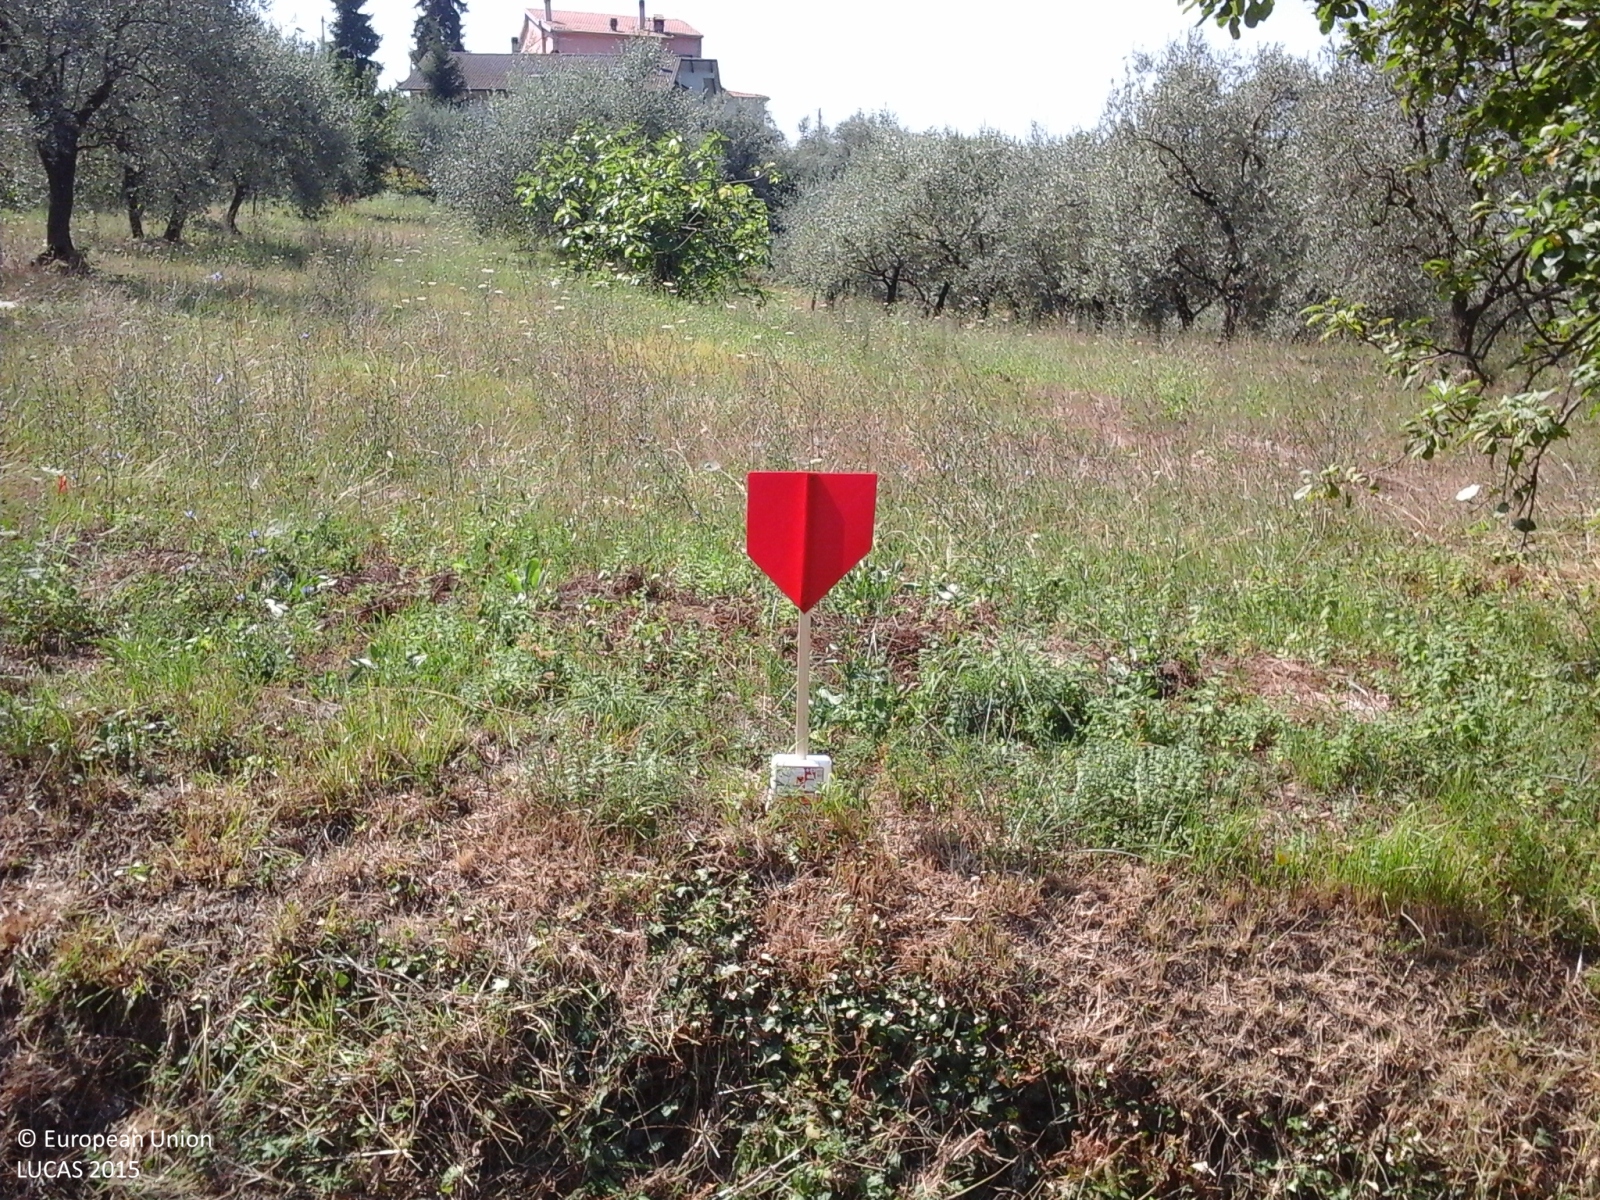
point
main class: Cropland
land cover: Olive groves
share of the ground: 25 - 50 %
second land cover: Grassland without tree/shrub cover
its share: 50 - 75 %
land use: Agriculture (excluding fallow land and kitchen gardens)
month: July
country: IT
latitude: 44.1882
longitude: 9.8877
